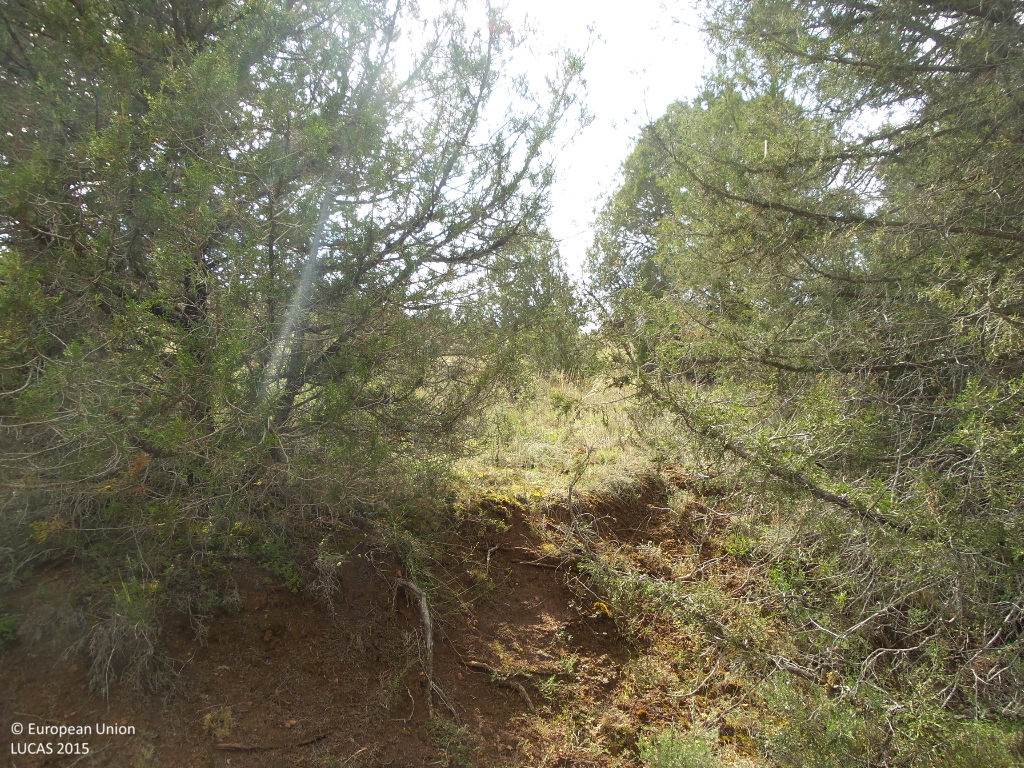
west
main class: Woodland
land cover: Other coniferous woodland
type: coniferous forest of the mediterranean region
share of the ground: 50 - 75 %
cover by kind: coniferous forest trees 50 %, herbaceous plants 30 %, shrubs 10 %, unconsolidated bare surface 10 %
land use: Forestry
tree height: > 5 m
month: June
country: ES
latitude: 41.4778
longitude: -3.1805
